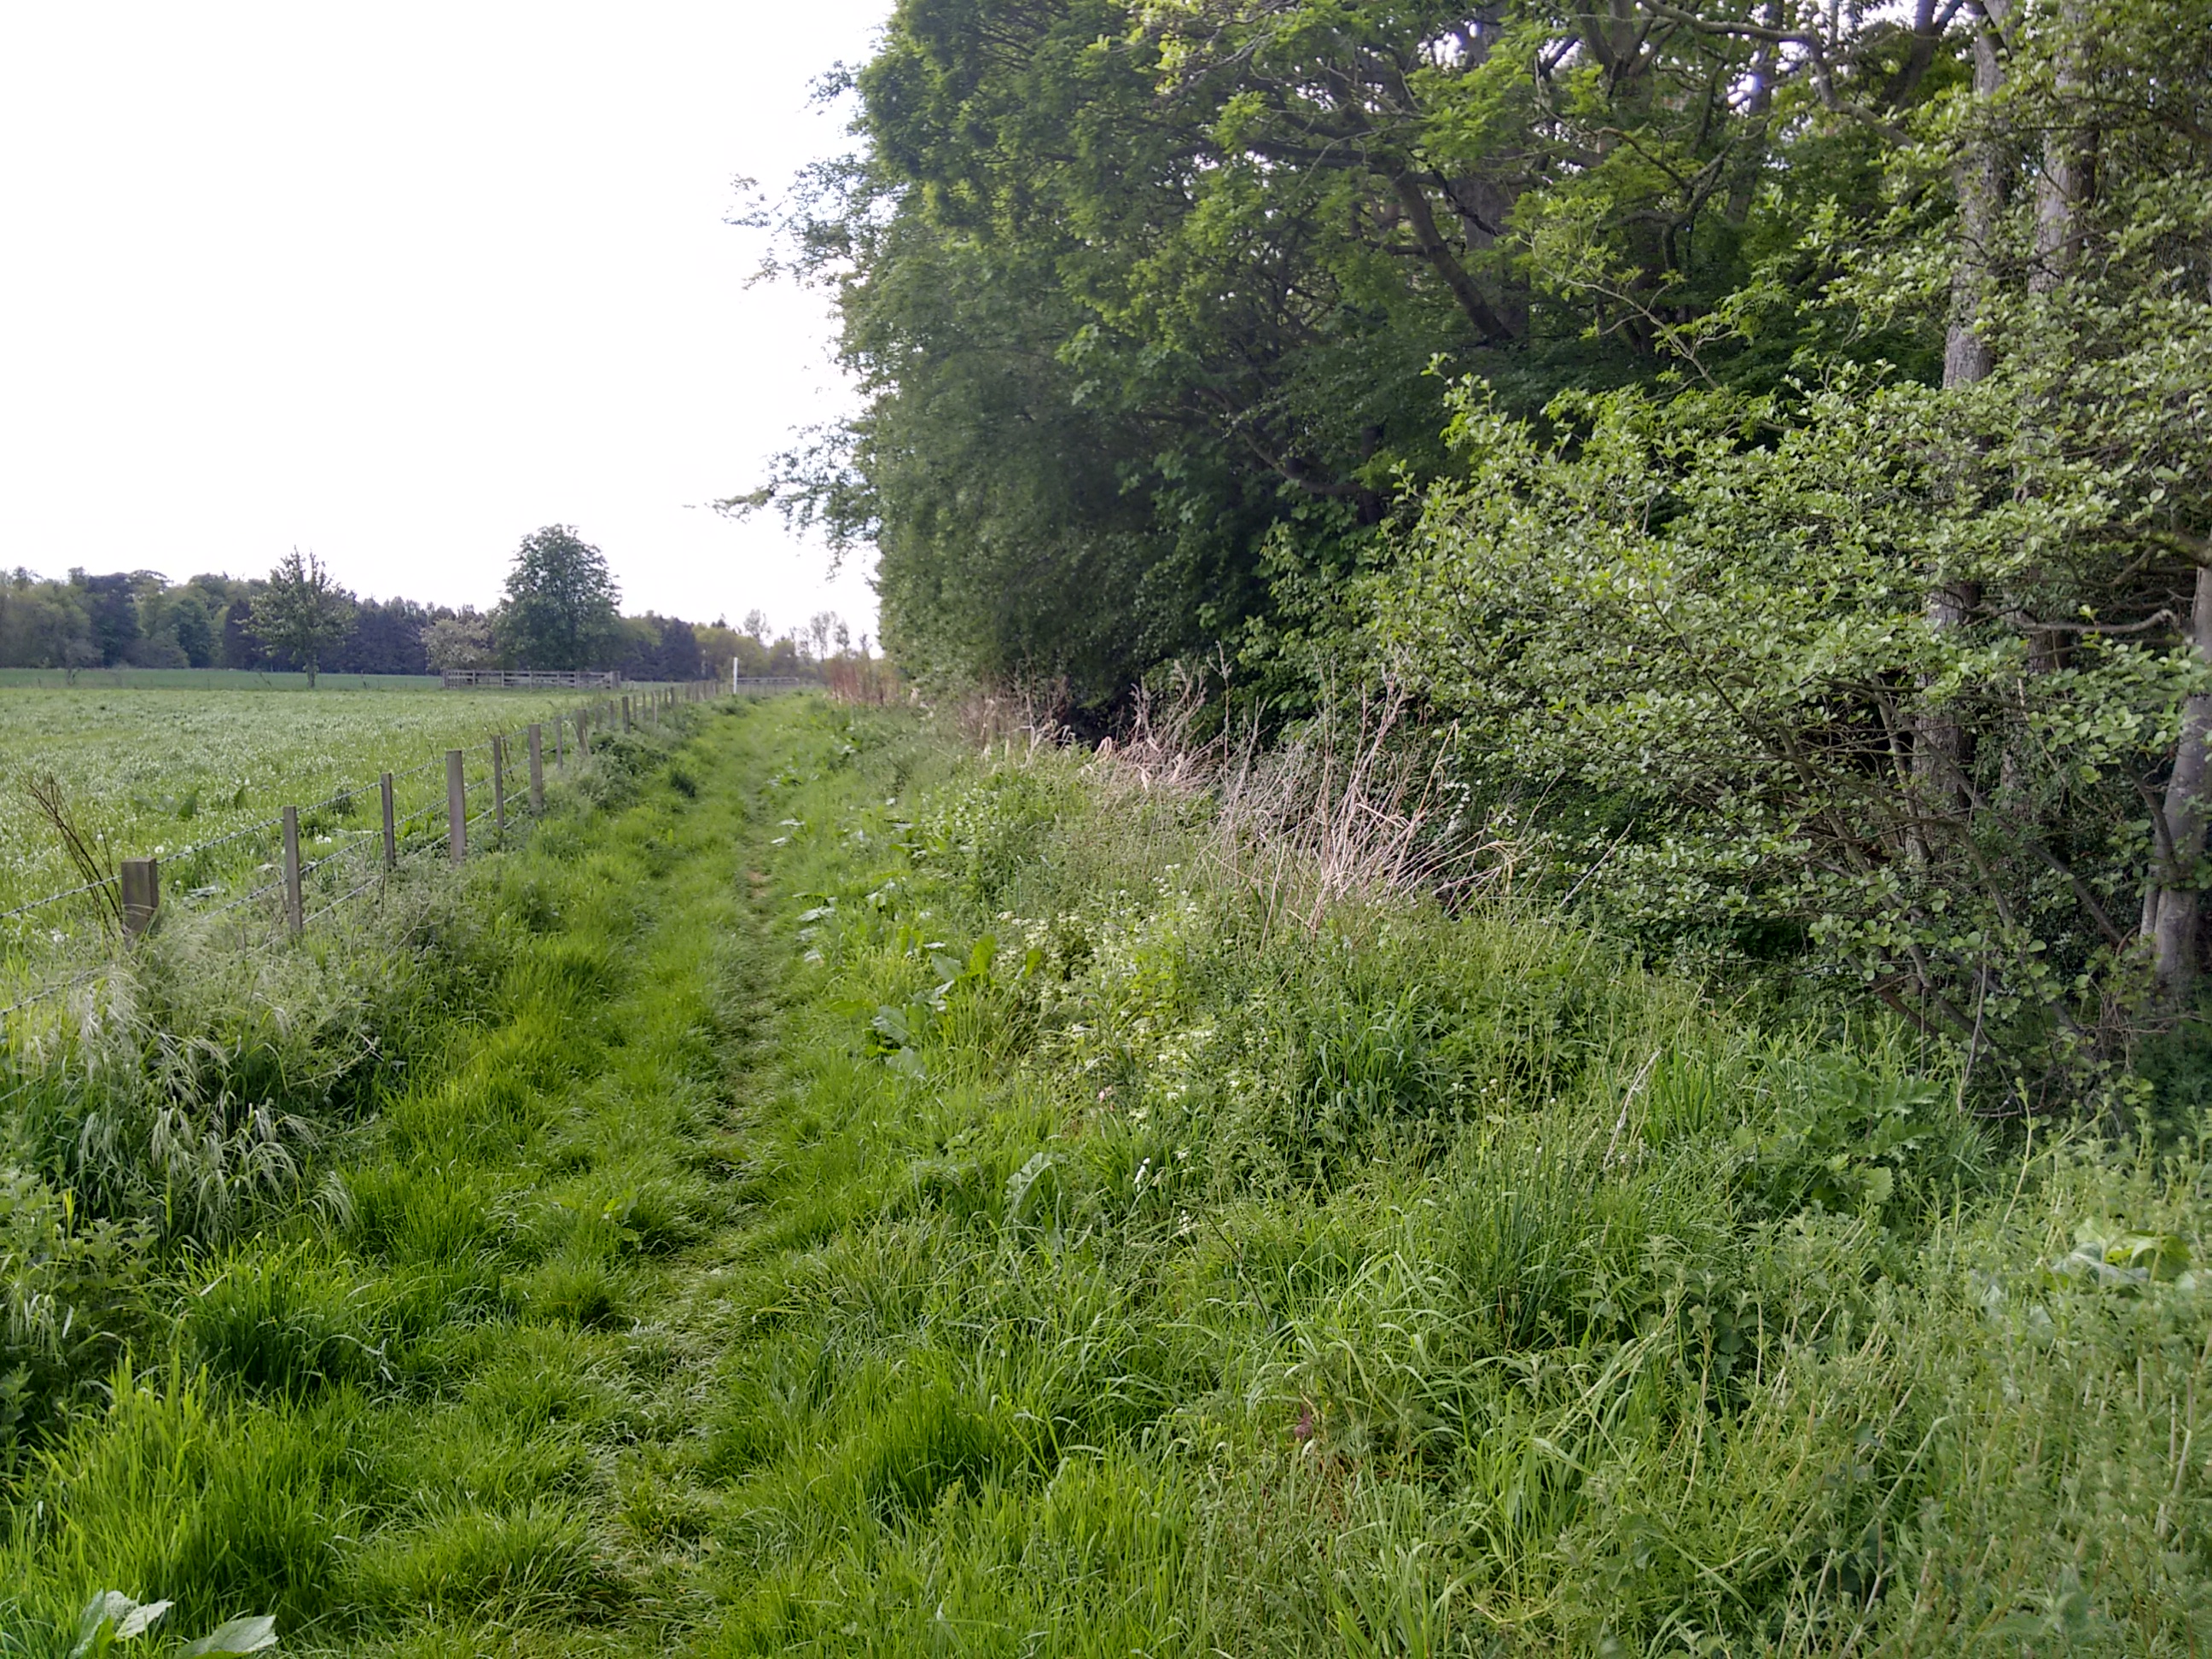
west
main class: Grassland
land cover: Grassland without tree/shrub cover
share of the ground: 50 - 75 %
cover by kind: herbaceous plants 100 %
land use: Agriculture (excluding fallow land and kitchen gardens)
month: May
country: GB
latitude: 55.9146
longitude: -2.9142
